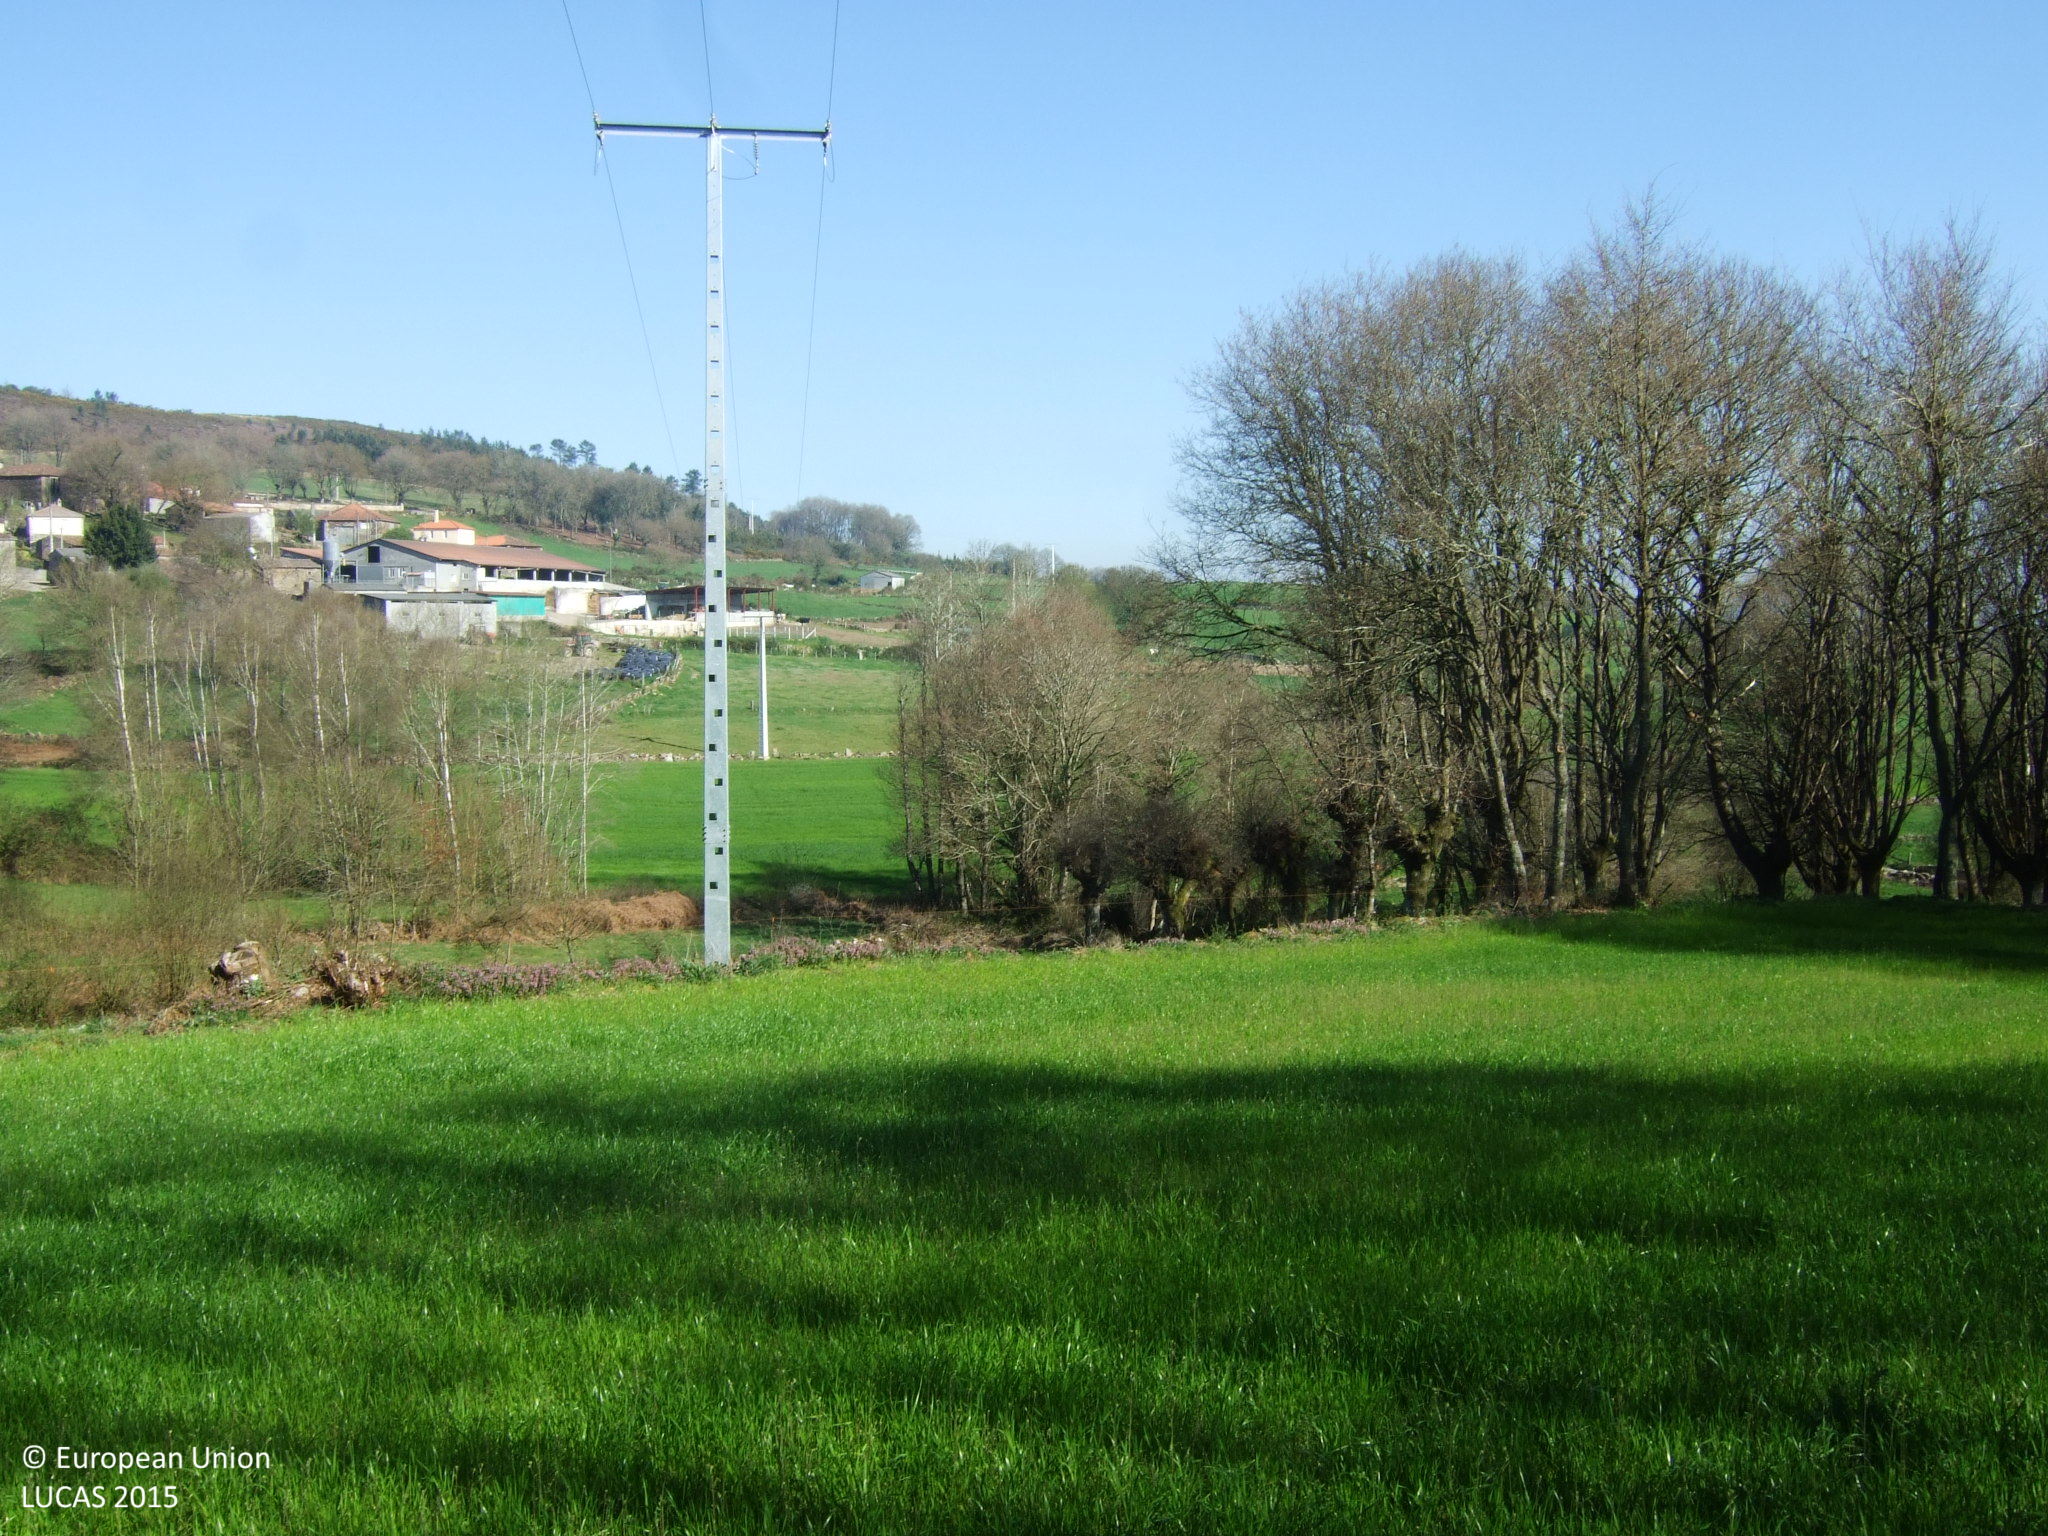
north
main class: Cropland
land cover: Temporary grasslands
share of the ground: > 75 %
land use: Agriculture (excluding fallow land and kitchen gardens)
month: April
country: ES
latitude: 42.7358
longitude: -7.8291
